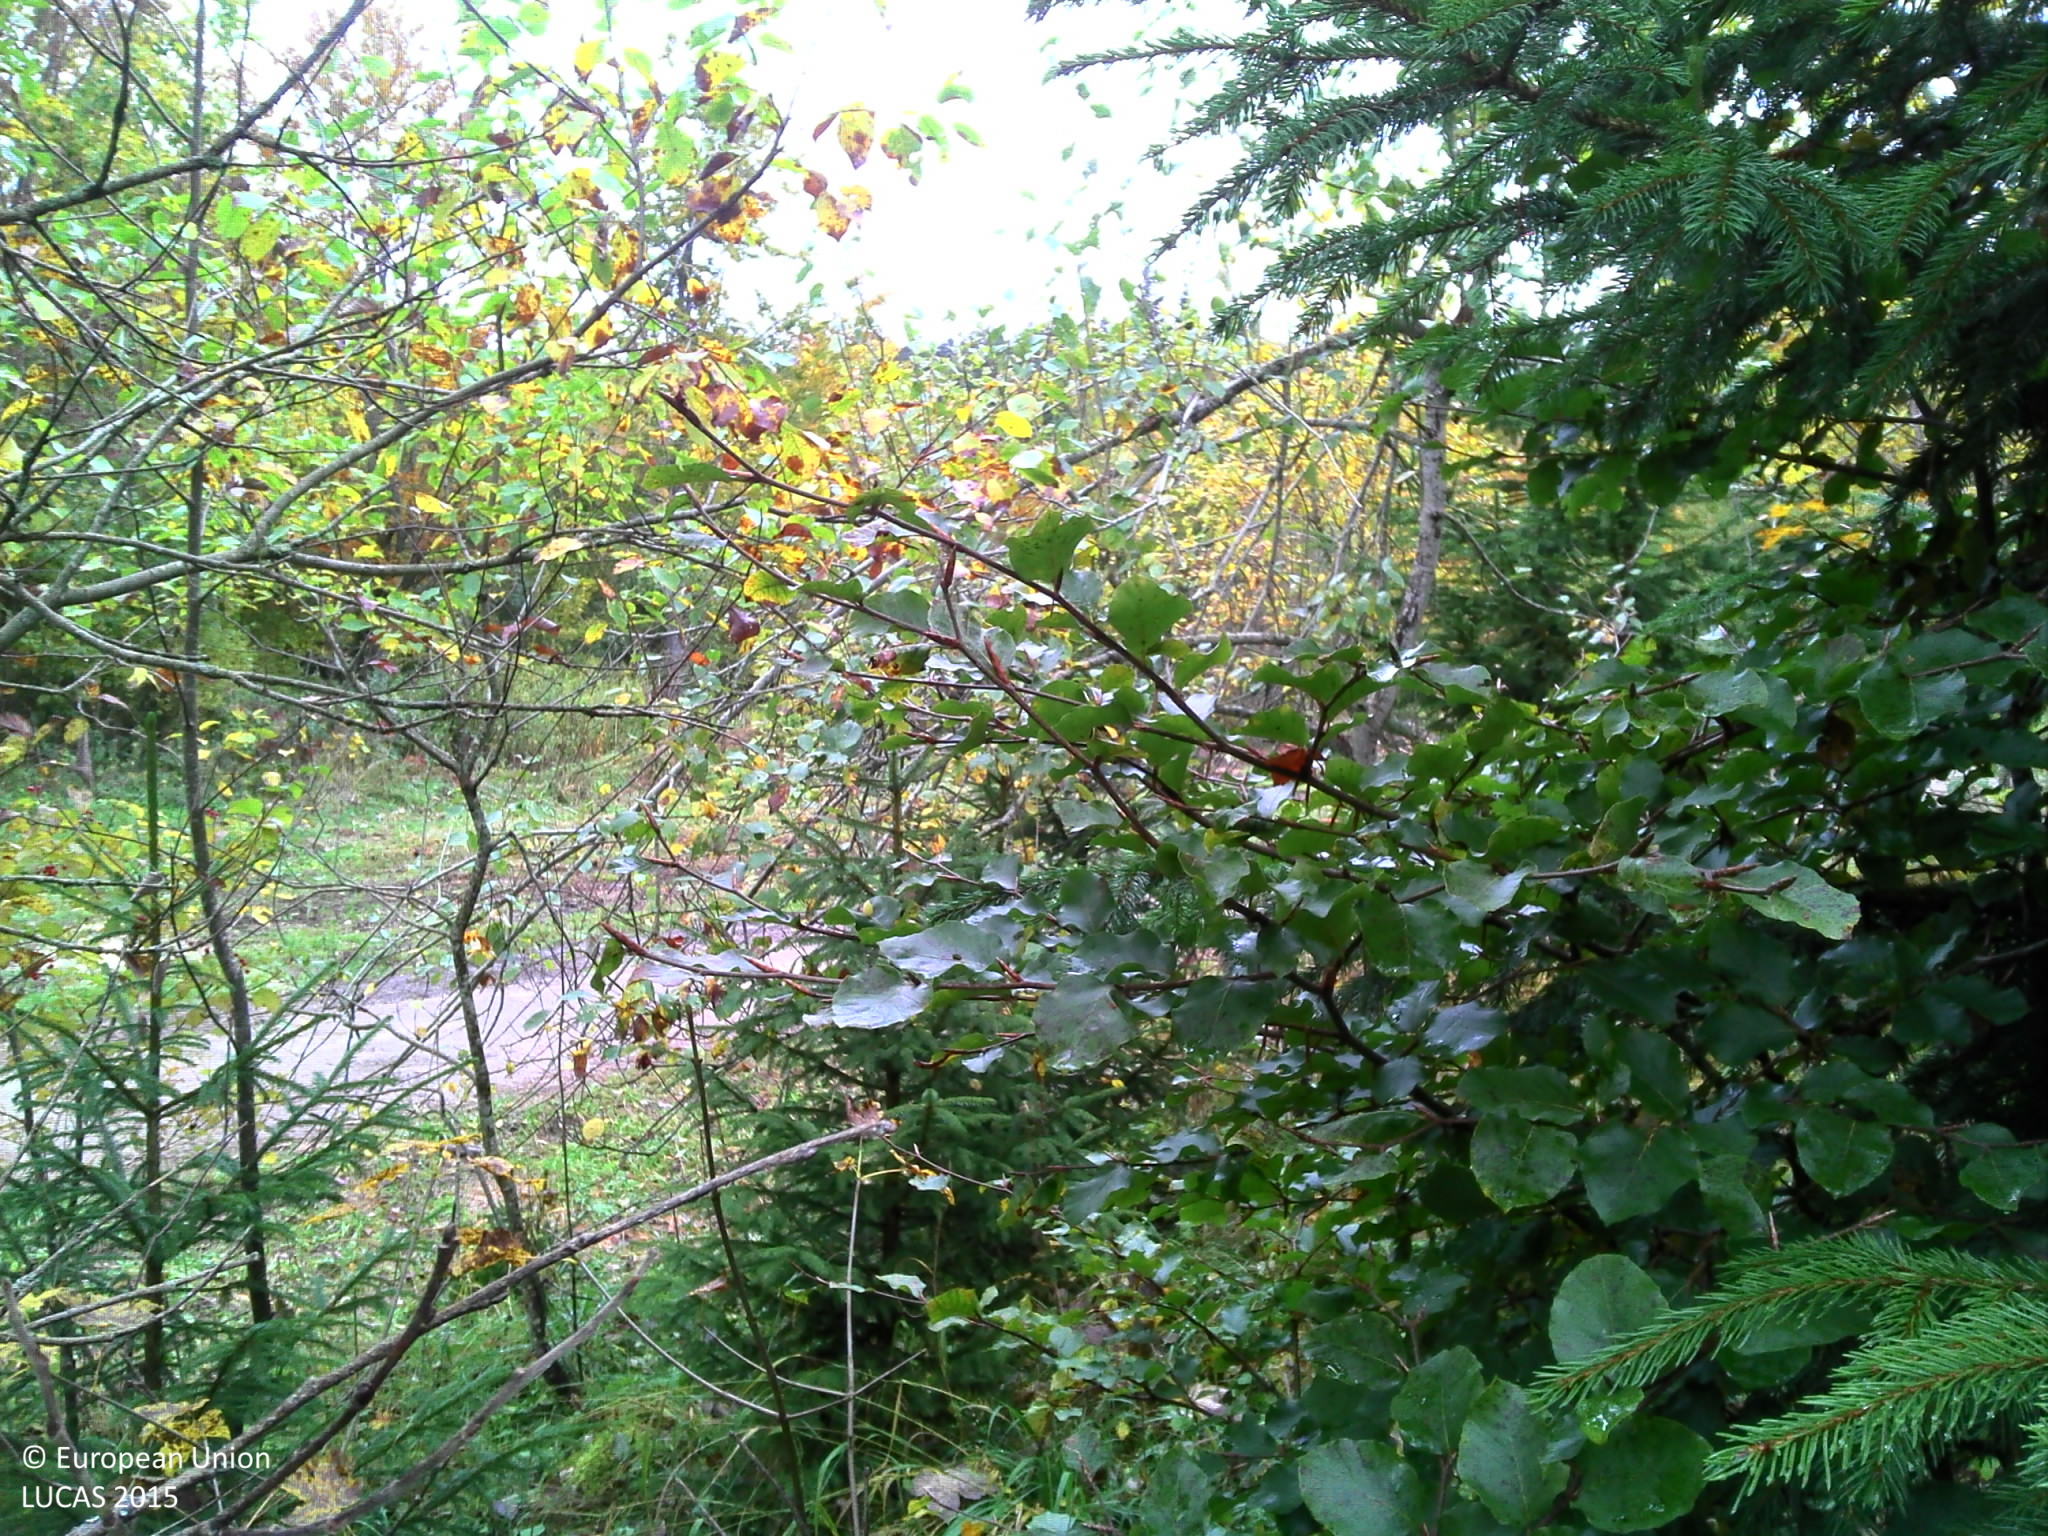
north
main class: Woodland
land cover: Spruce dominated mixed woodland
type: hemiboreal forest and nemoral coniferous forest and mixed broadleaved-coniferous forest
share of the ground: > 75 %
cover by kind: coniferous forest trees 40 %, broadleaved forest trees 40 %, shrubs 20 %
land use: Semi-natural and natural areas not in use
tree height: < 5 m
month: October
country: FR
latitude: 46.8493
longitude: 6.3960
